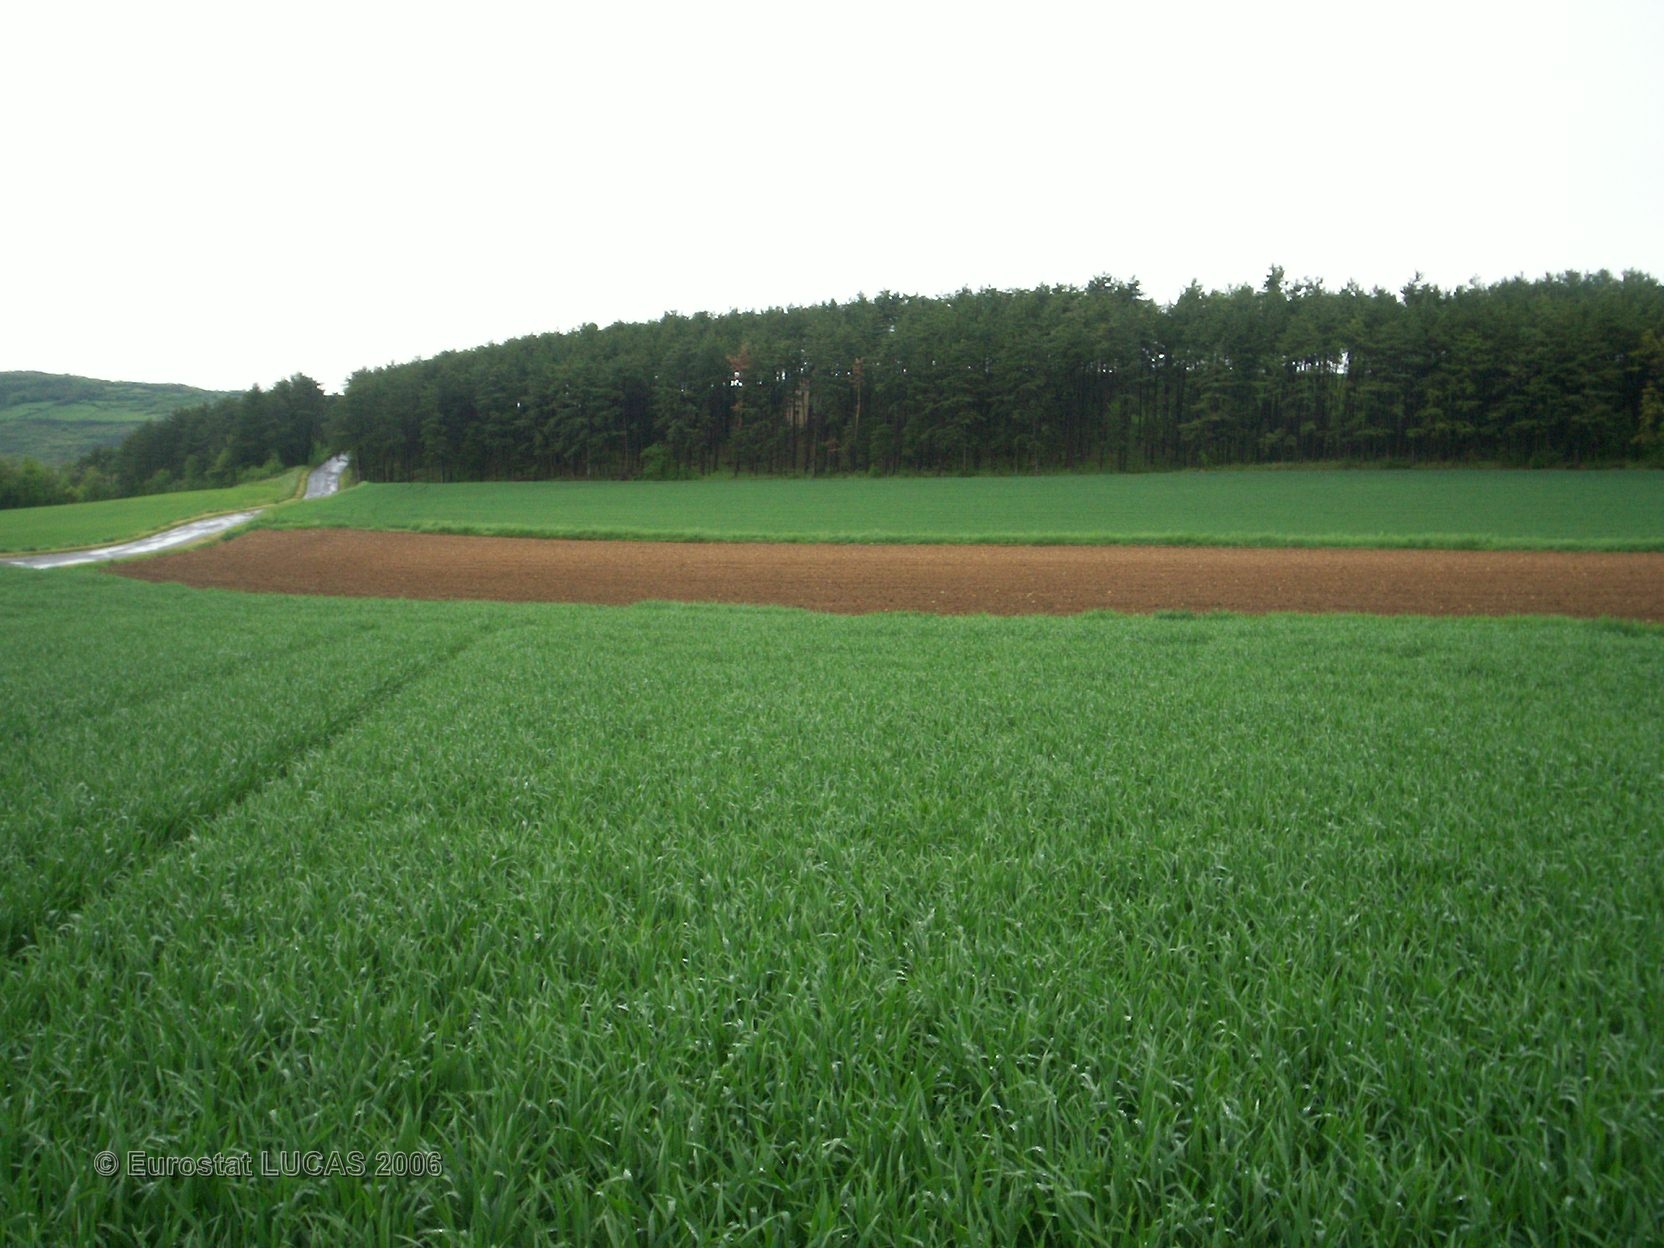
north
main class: Cropland
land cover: Common wheat
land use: Agriculture (excluding fallow land and kitchen gardens)
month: May
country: FR
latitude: 45.4306
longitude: 3.2140
